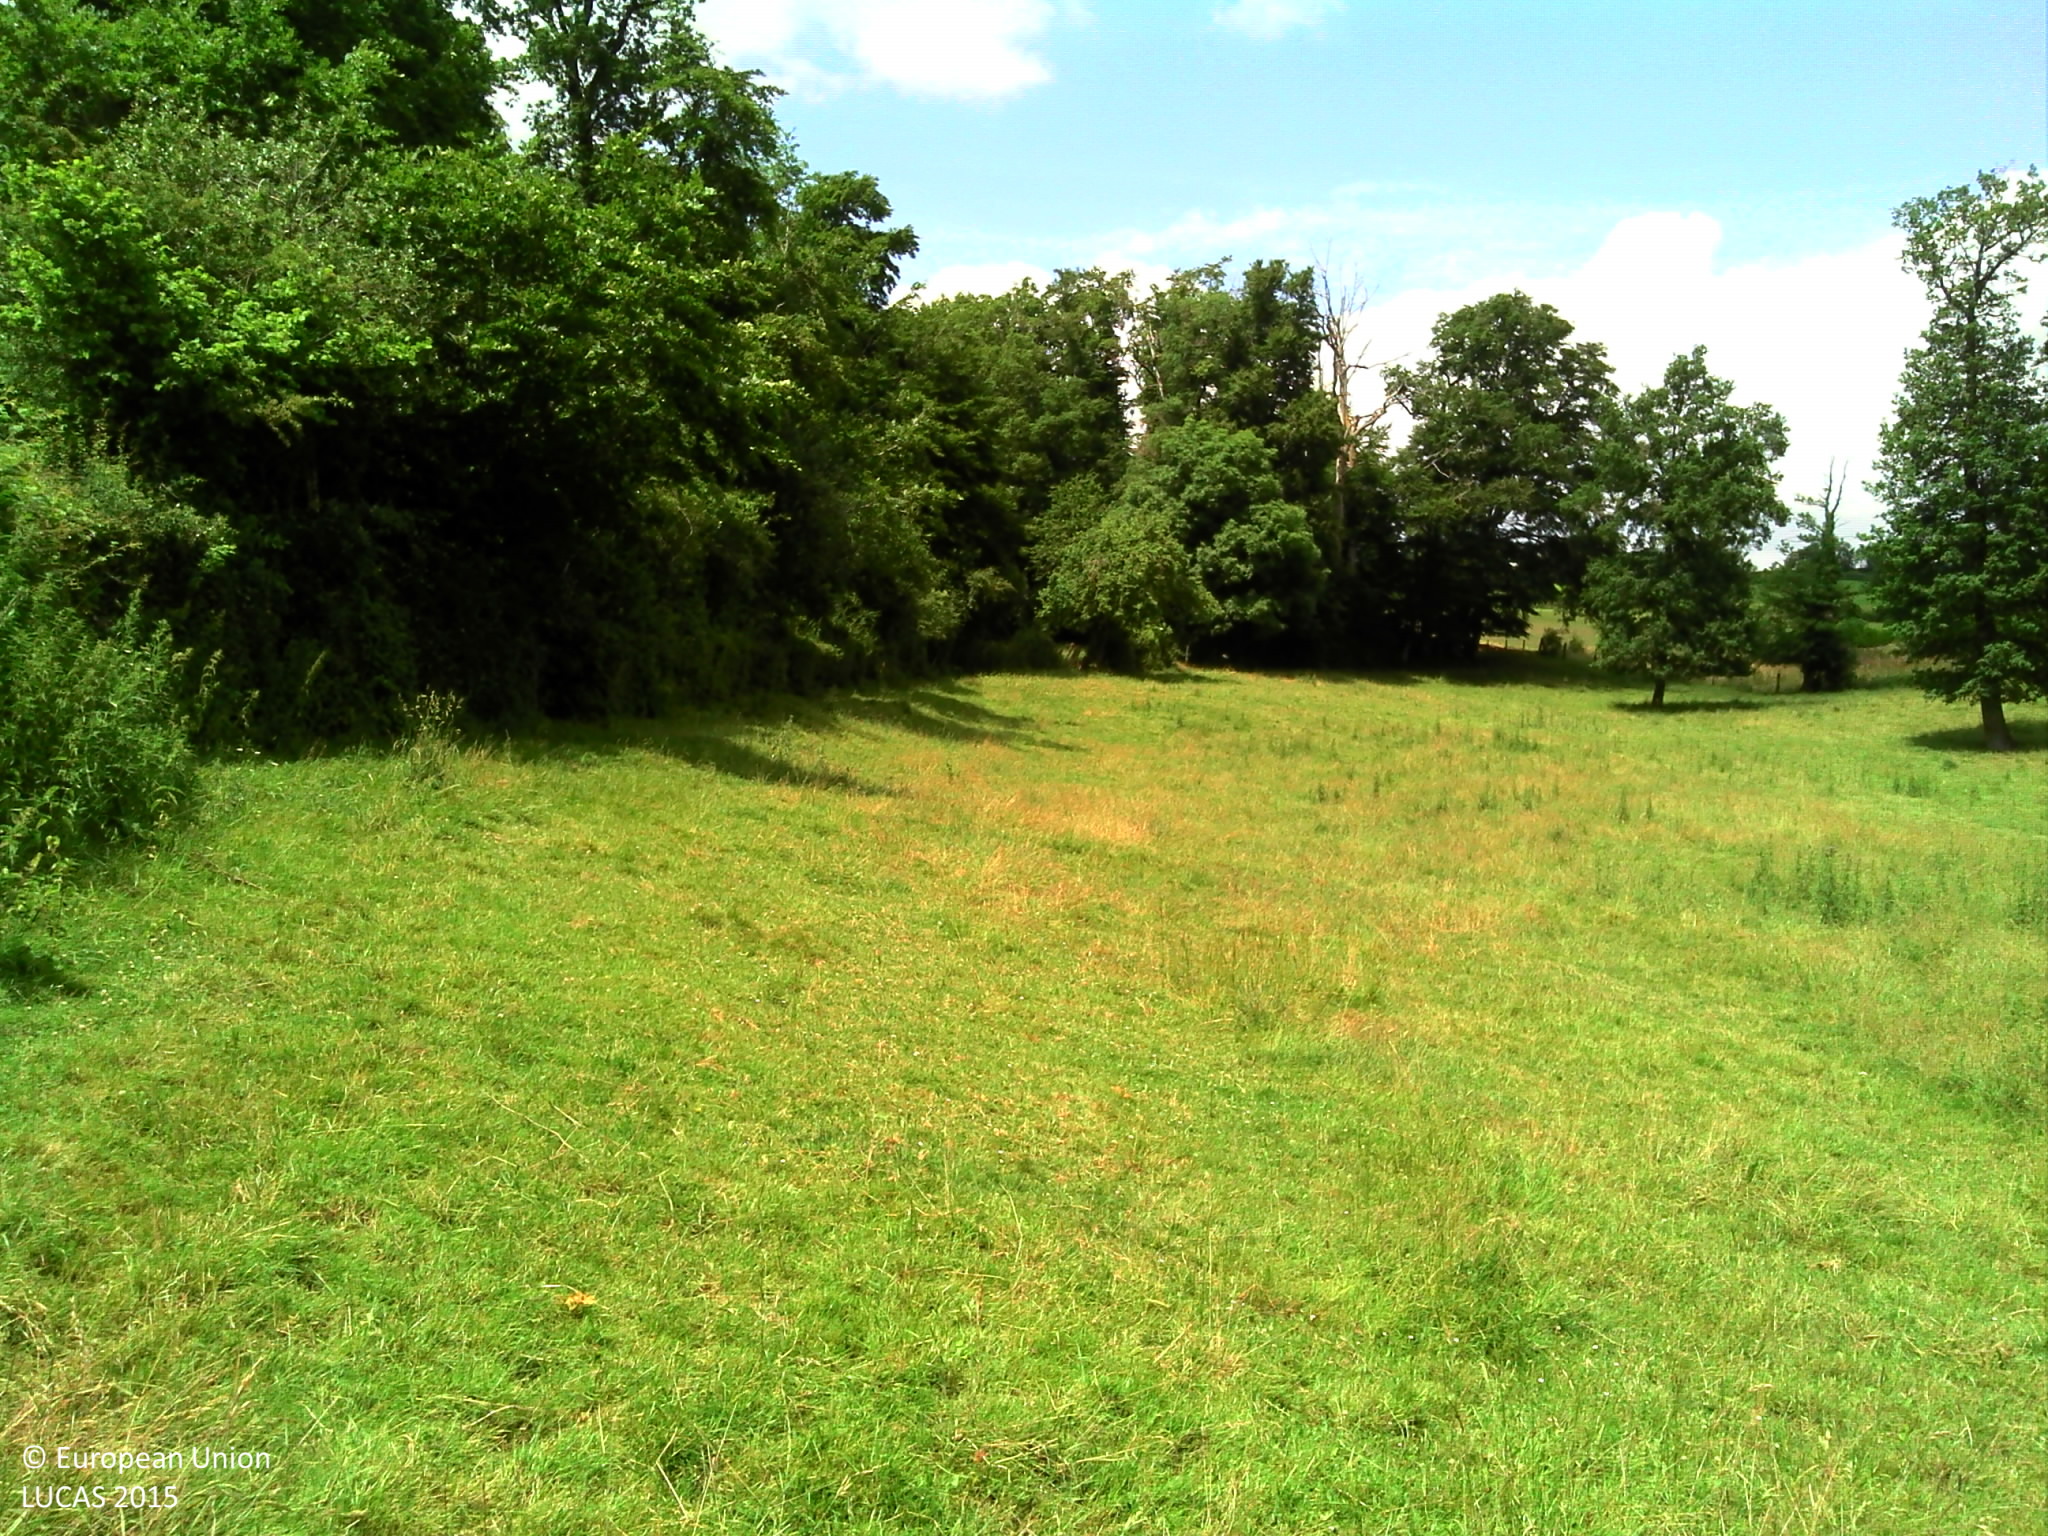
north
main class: Grassland
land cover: Grassland without tree/shrub cover
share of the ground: > 75 %
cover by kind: herbaceous plants 100 %
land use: Agriculture (excluding fallow land and kitchen gardens)
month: June
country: FR
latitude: 44.2780
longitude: 2.4983
